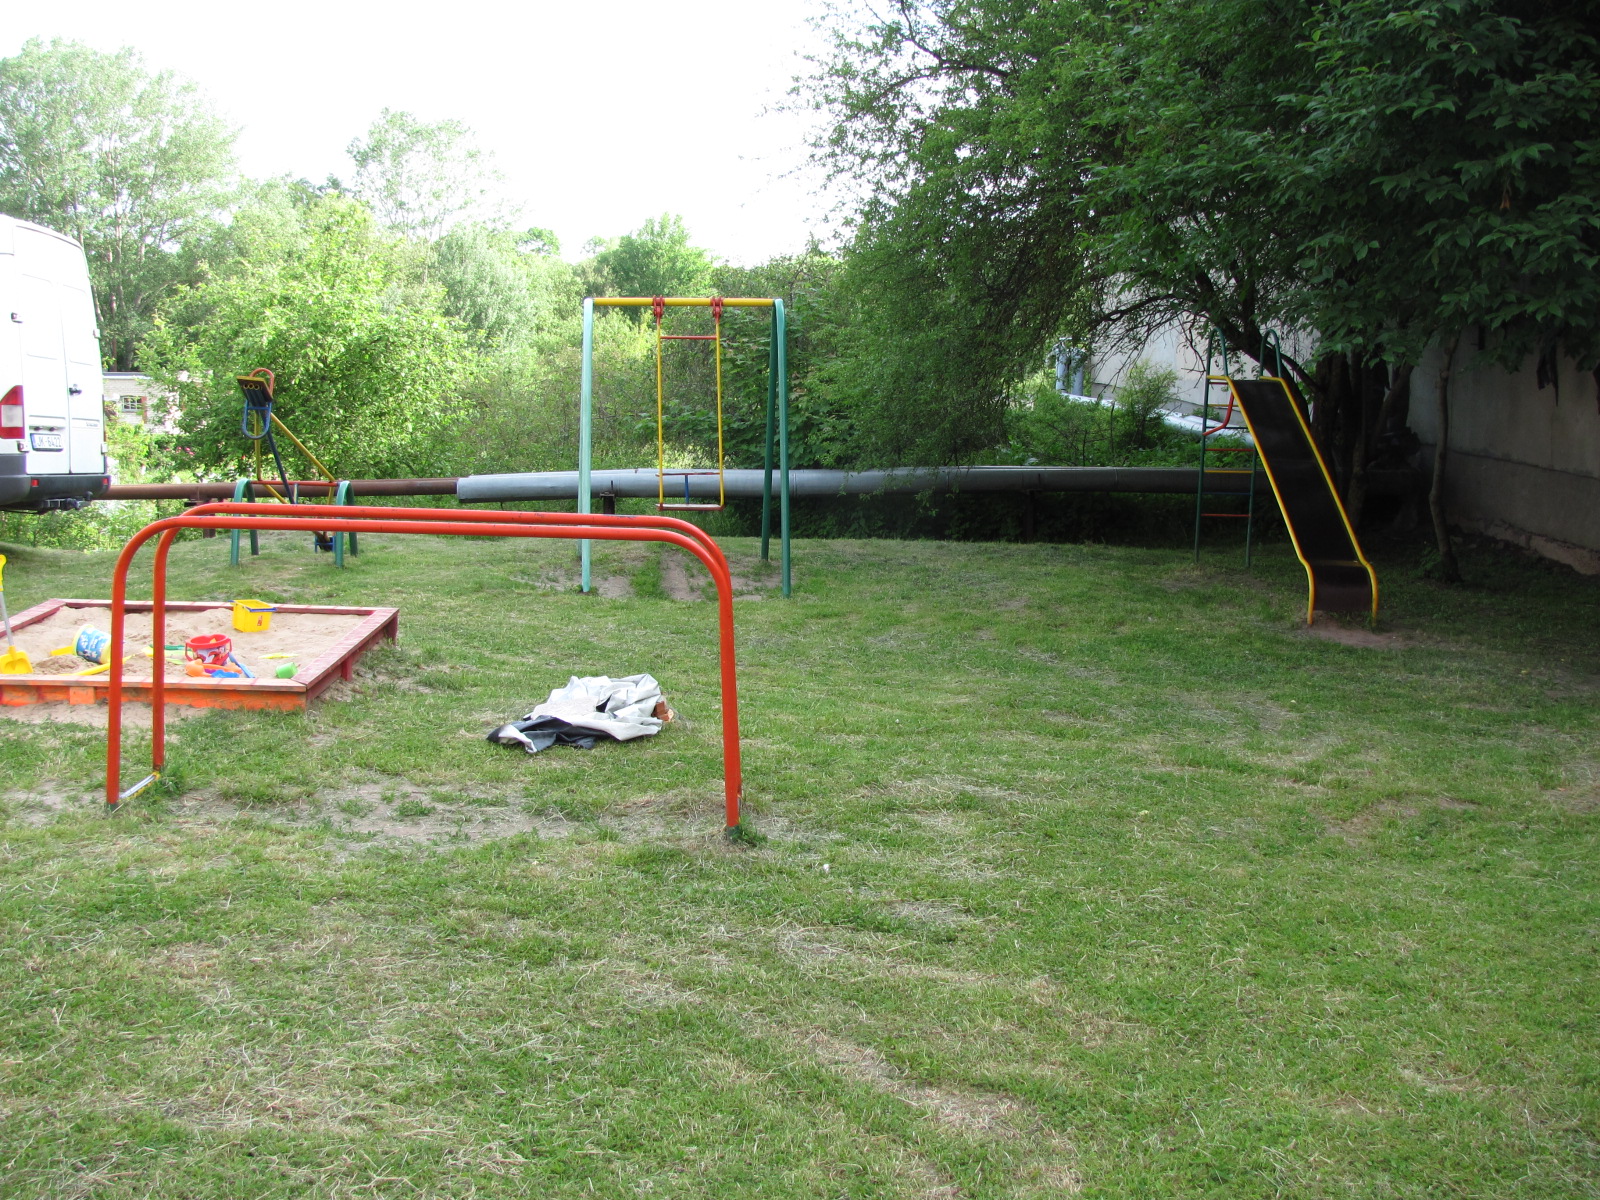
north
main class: Grassland
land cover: Grassland without tree/shrub cover
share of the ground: > 75 %
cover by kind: herbaceous plants 100 %
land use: Amenities, museums, leisure
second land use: Residential
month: June
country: LV
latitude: 56.3983
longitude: 24.2018
